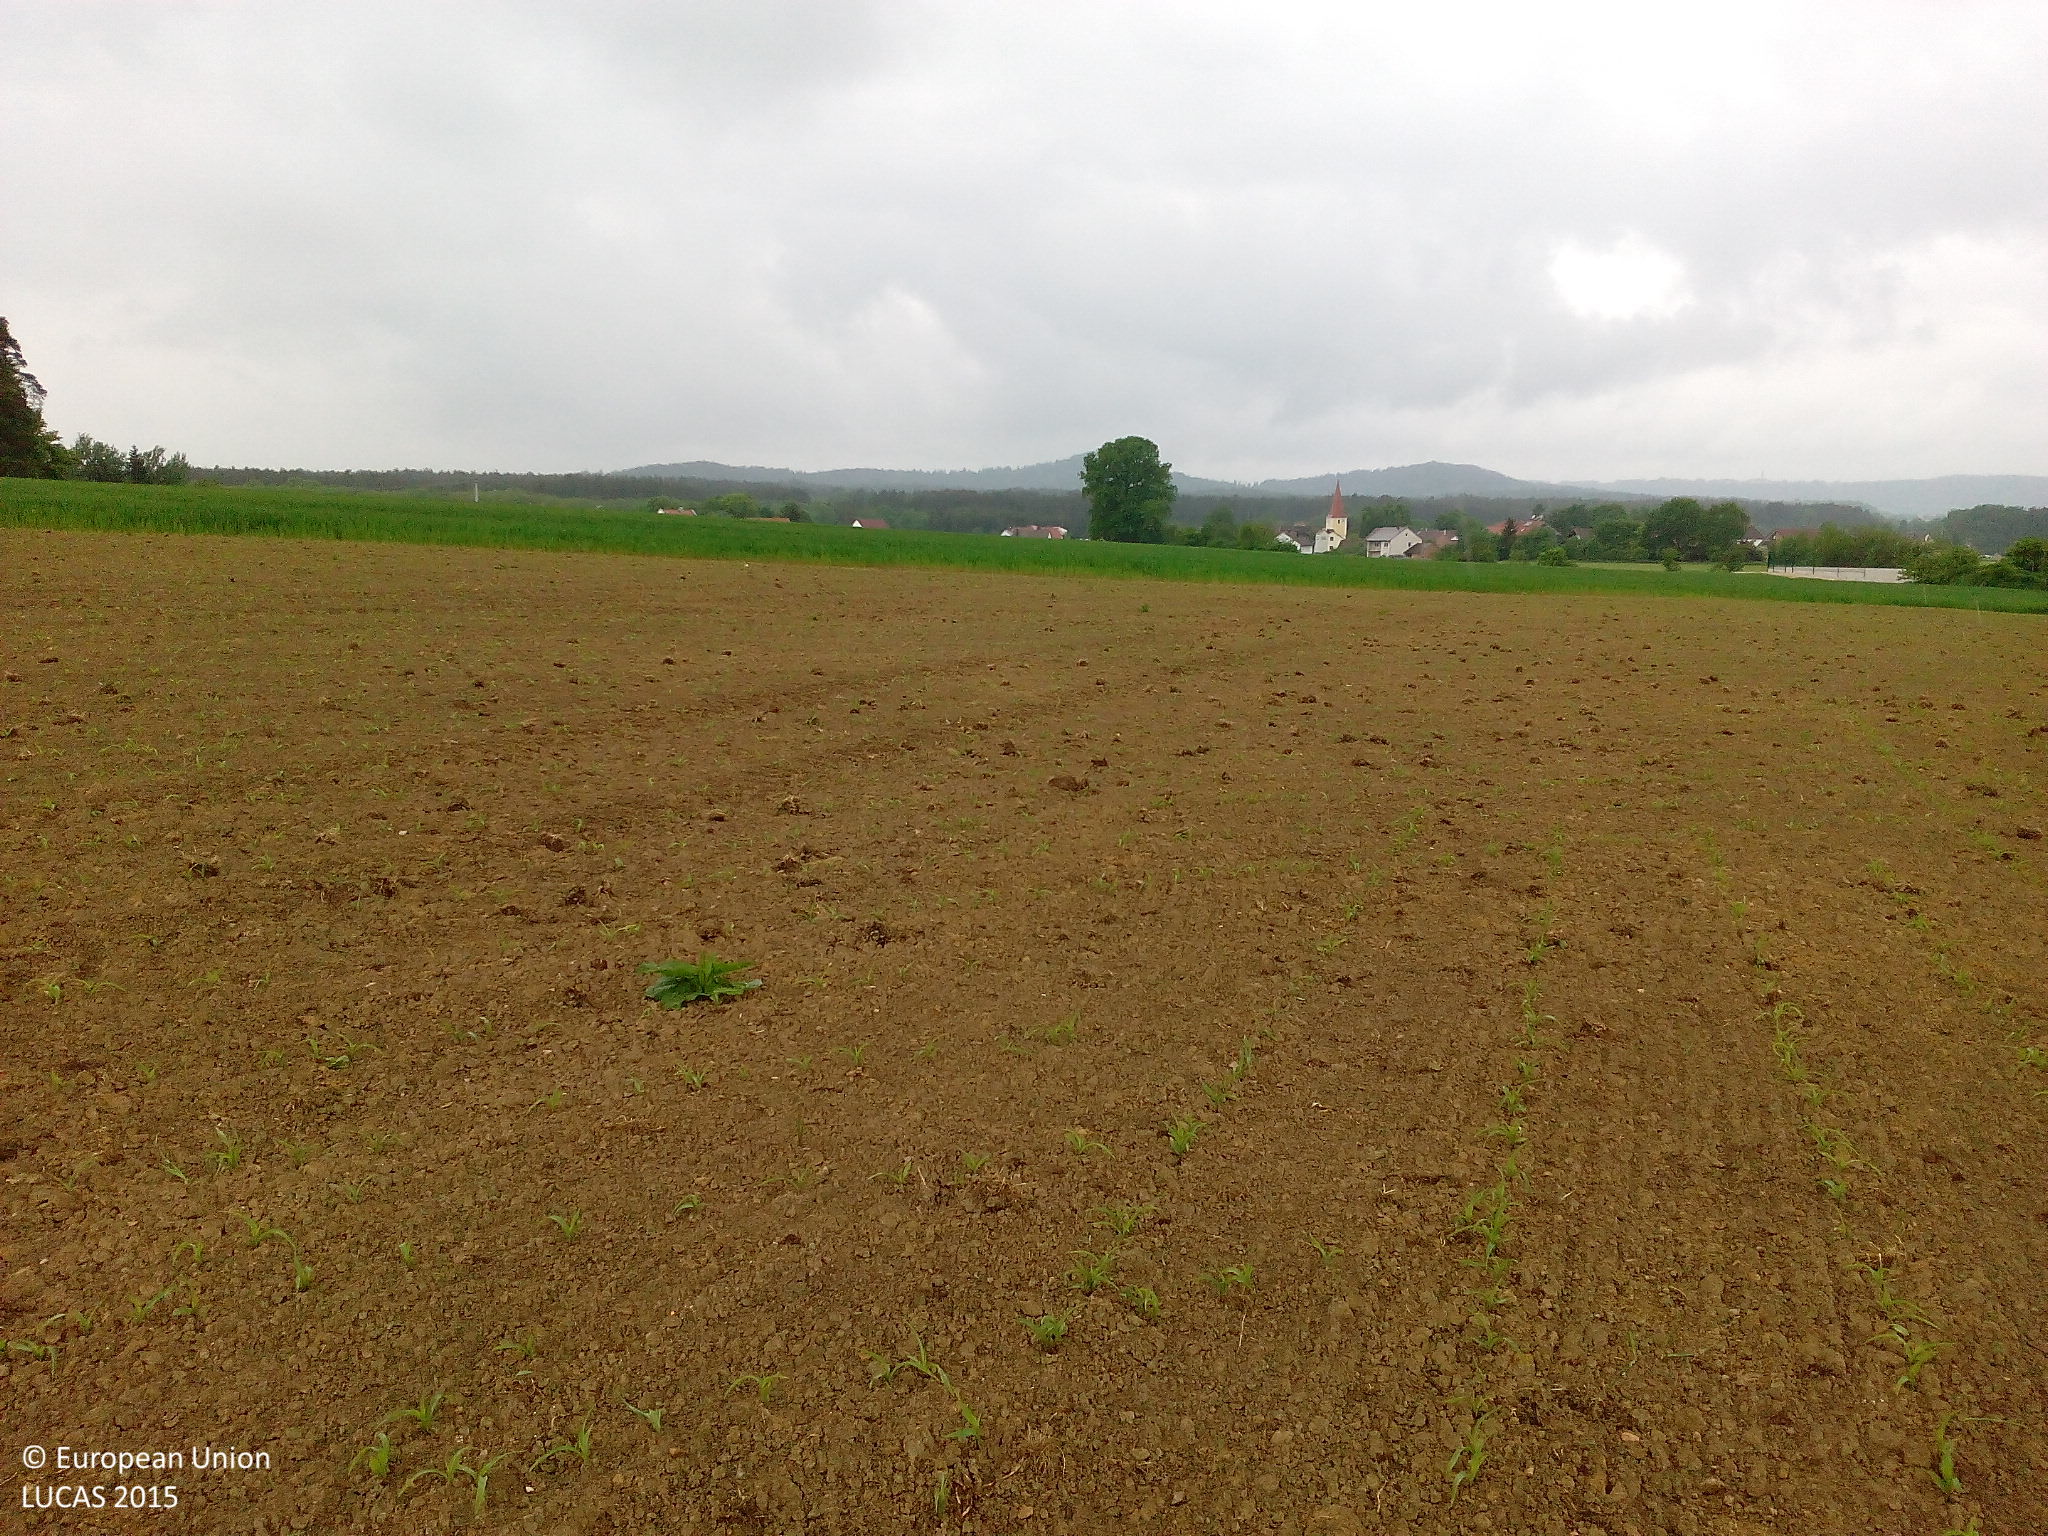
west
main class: Cropland
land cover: Maize
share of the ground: < 10 %
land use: Agriculture (excluding fallow land and kitchen gardens)
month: May
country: DE
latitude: 49.3113
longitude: 11.4713
